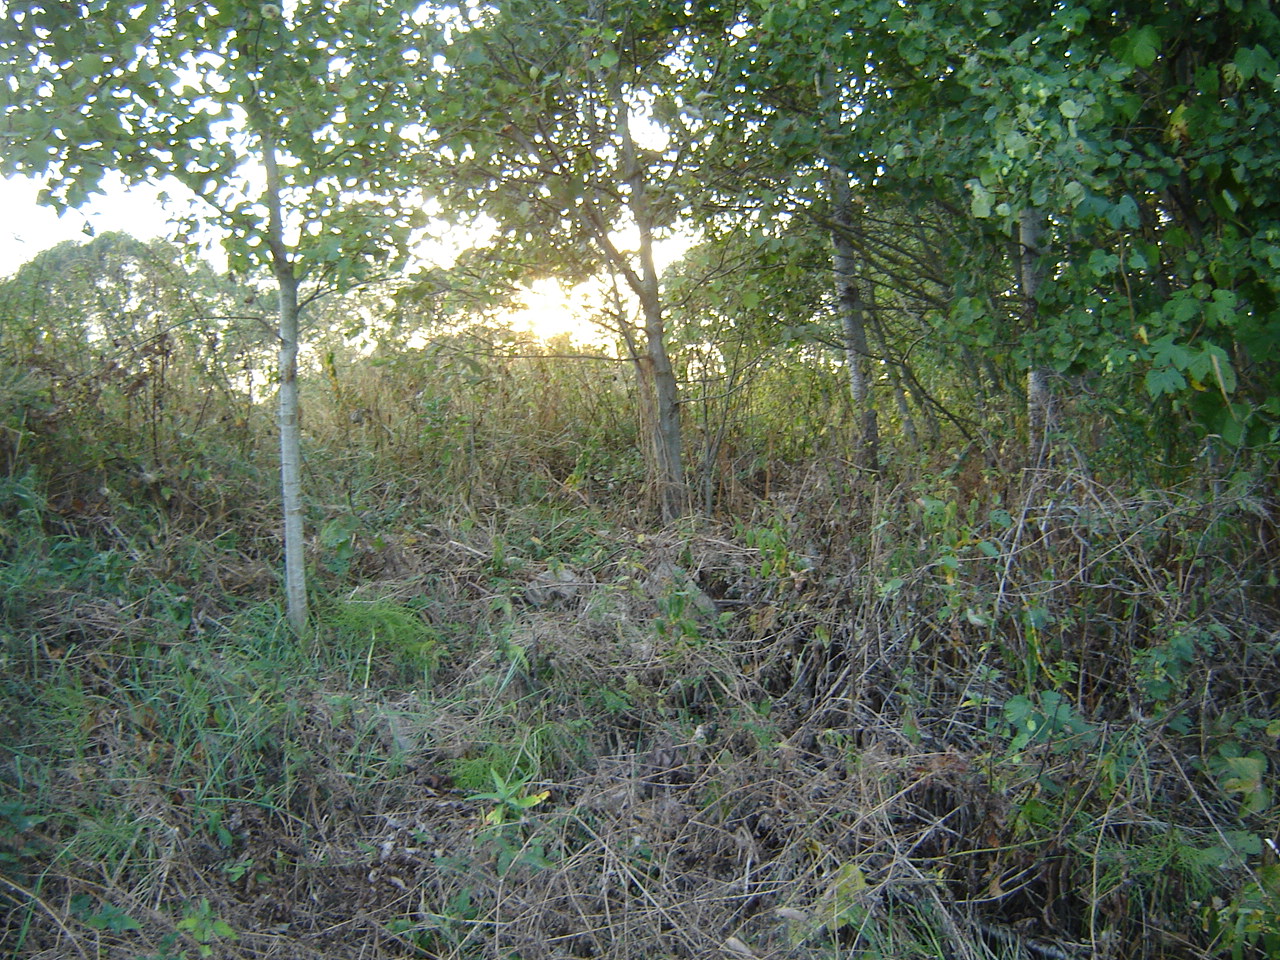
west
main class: Grassland
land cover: Spontaneously vegetated surfaces
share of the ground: > 75 %
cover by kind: herbaceous plants 100 %
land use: Semi-natural and natural areas not in use
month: August
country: LT
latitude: 54.7908
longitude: 24.8062
